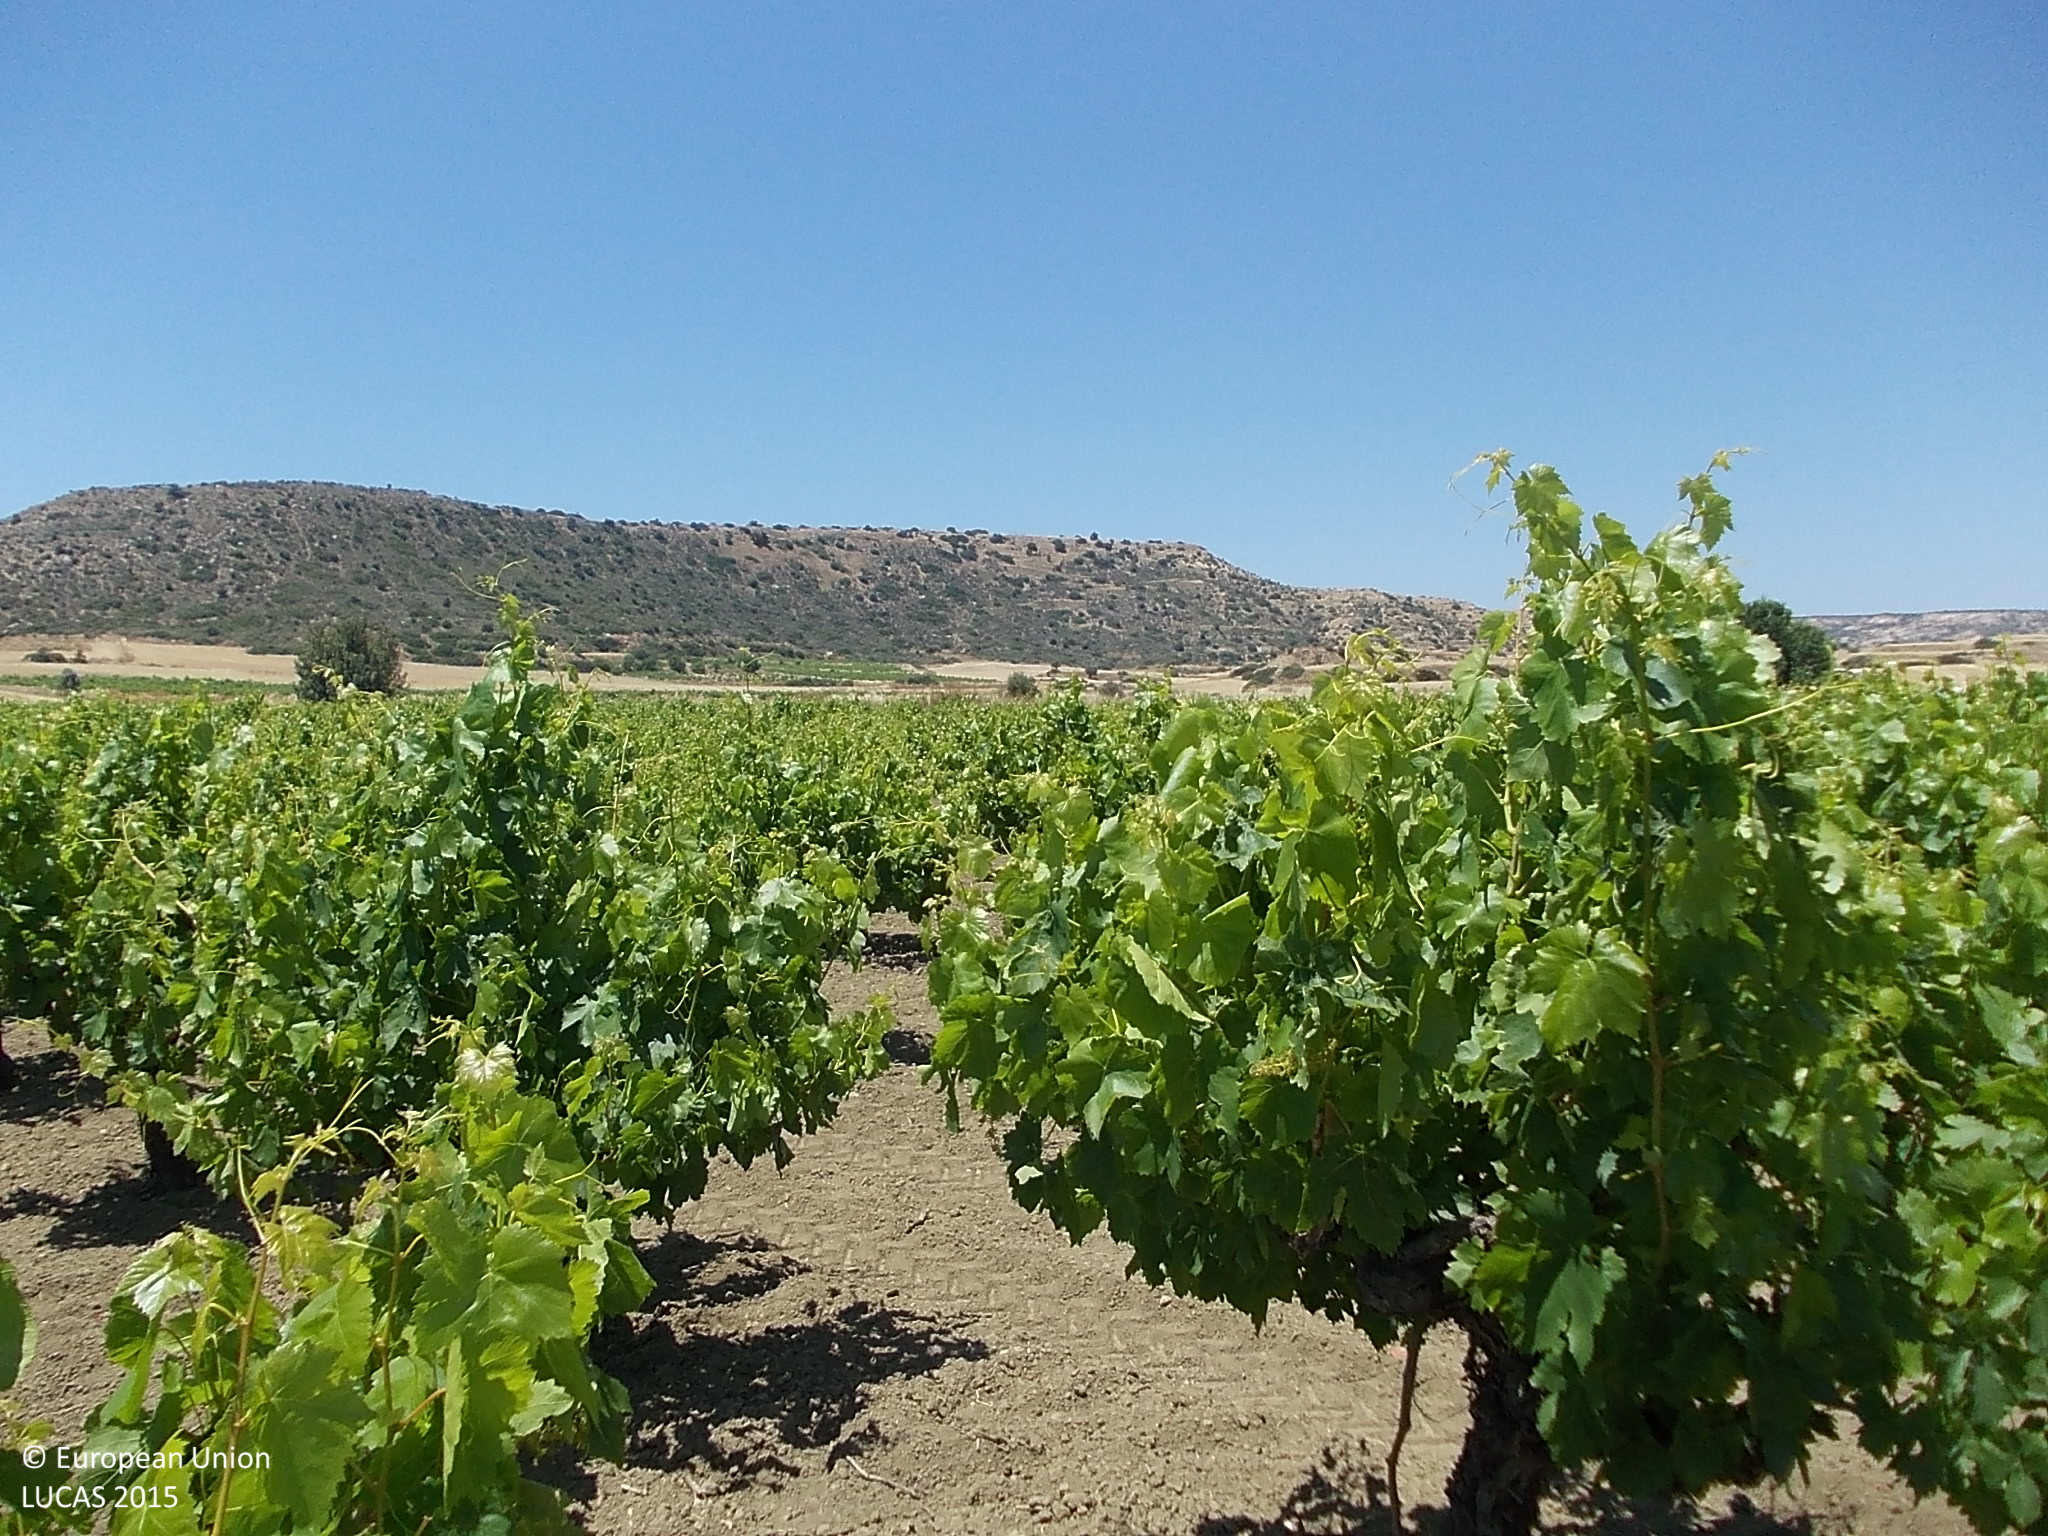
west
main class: Cropland
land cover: Vineyards
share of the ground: 50 - 75 %
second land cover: Other bare soil
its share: > 75 %
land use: Agriculture (excluding fallow land and kitchen gardens)
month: May
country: CY
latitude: 34.6690
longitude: 32.7542
